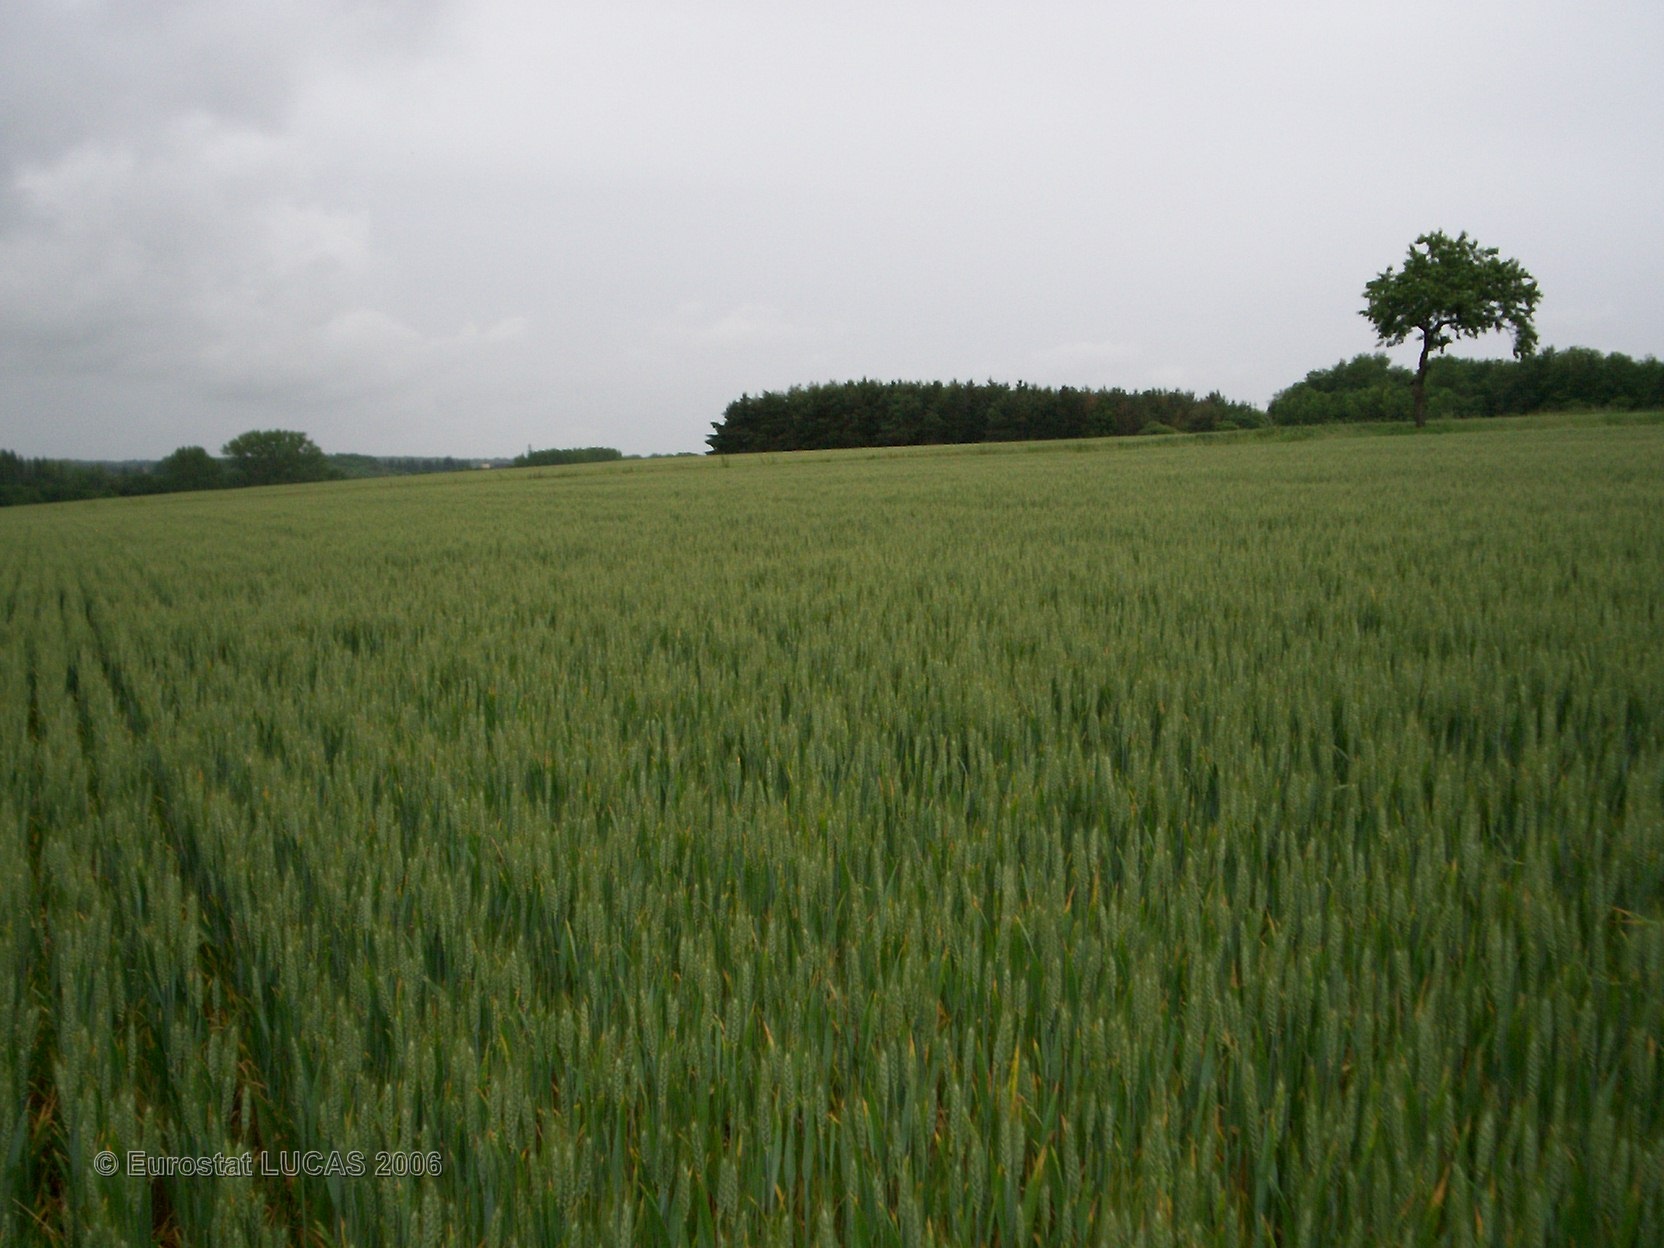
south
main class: Cropland
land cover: Common wheat
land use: Agriculture (excluding fallow land and kitchen gardens)
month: May
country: FR
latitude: 47.5215
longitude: 0.9112
